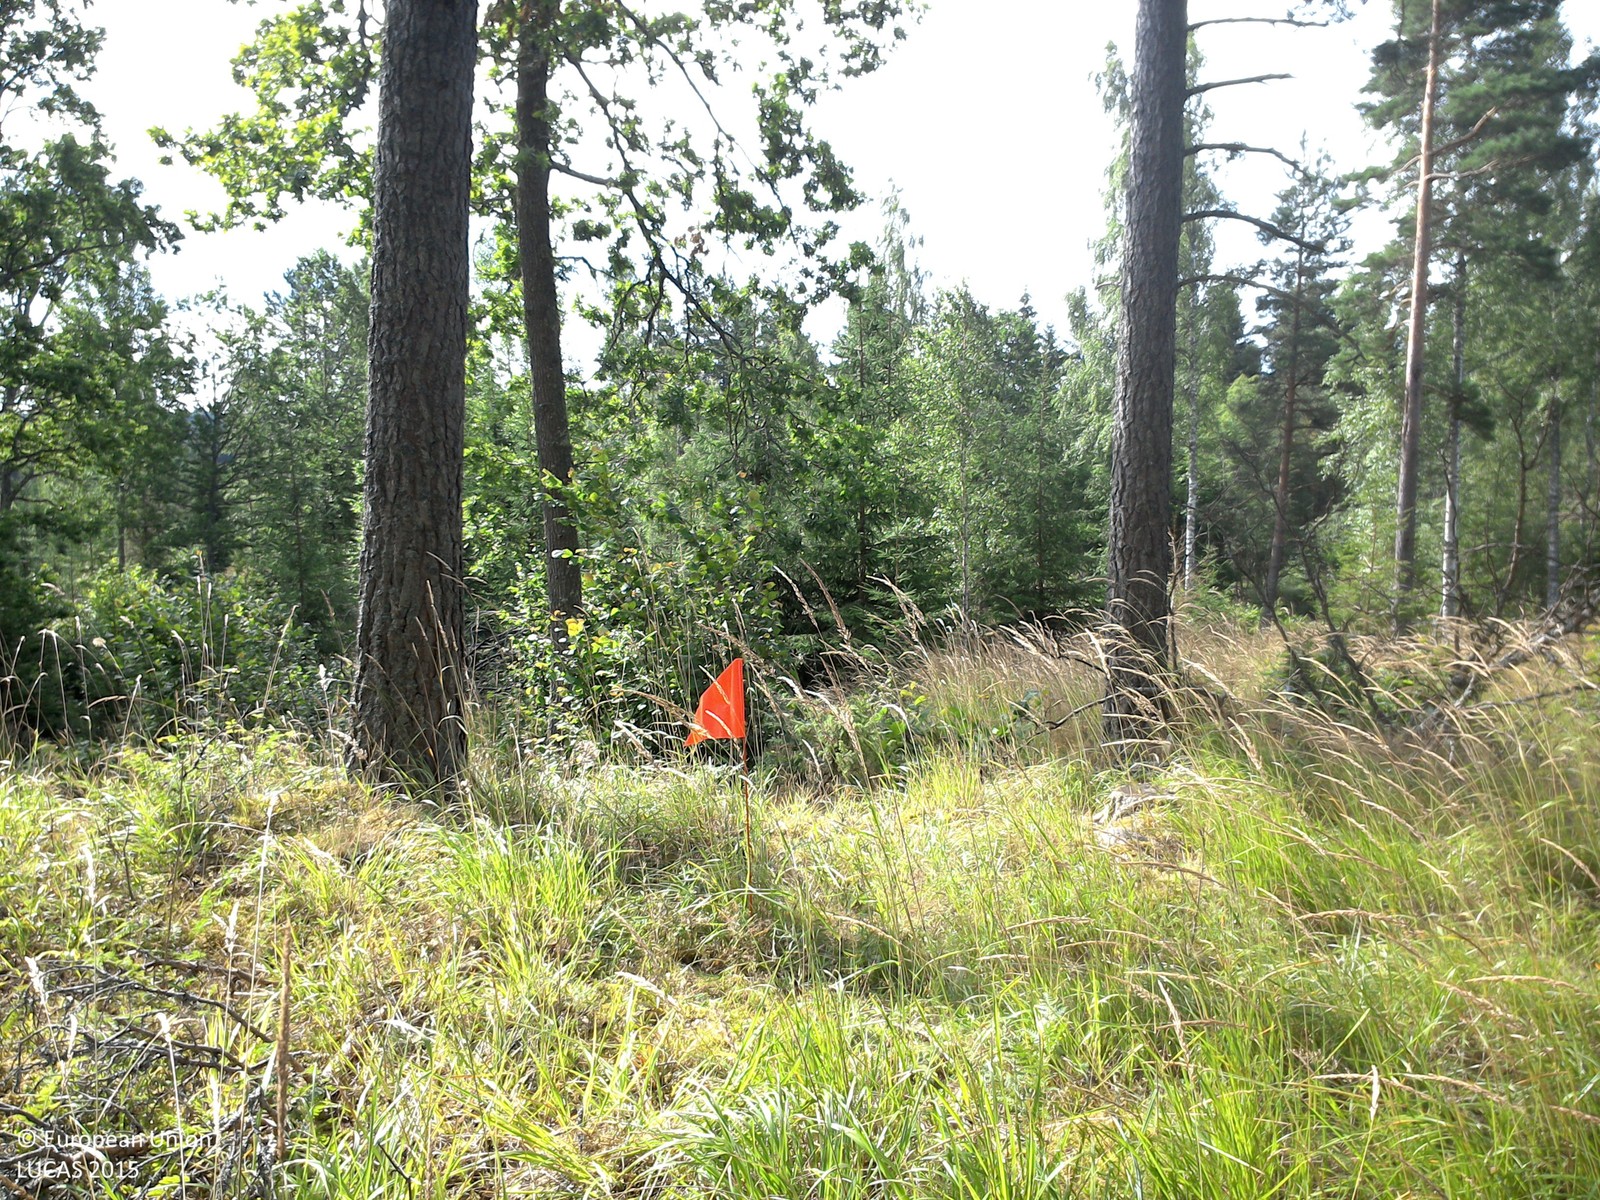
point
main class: Woodland
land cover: Pine dominated coniferous woodland
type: boreal forest
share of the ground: 50 - 75 %
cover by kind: coniferous forest trees 55 %, herbaceous plants 25 %, lichens and mosses 20 %
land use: Forestry
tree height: > 5 m
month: July
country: SE
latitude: 57.8848
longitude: 16.0515
